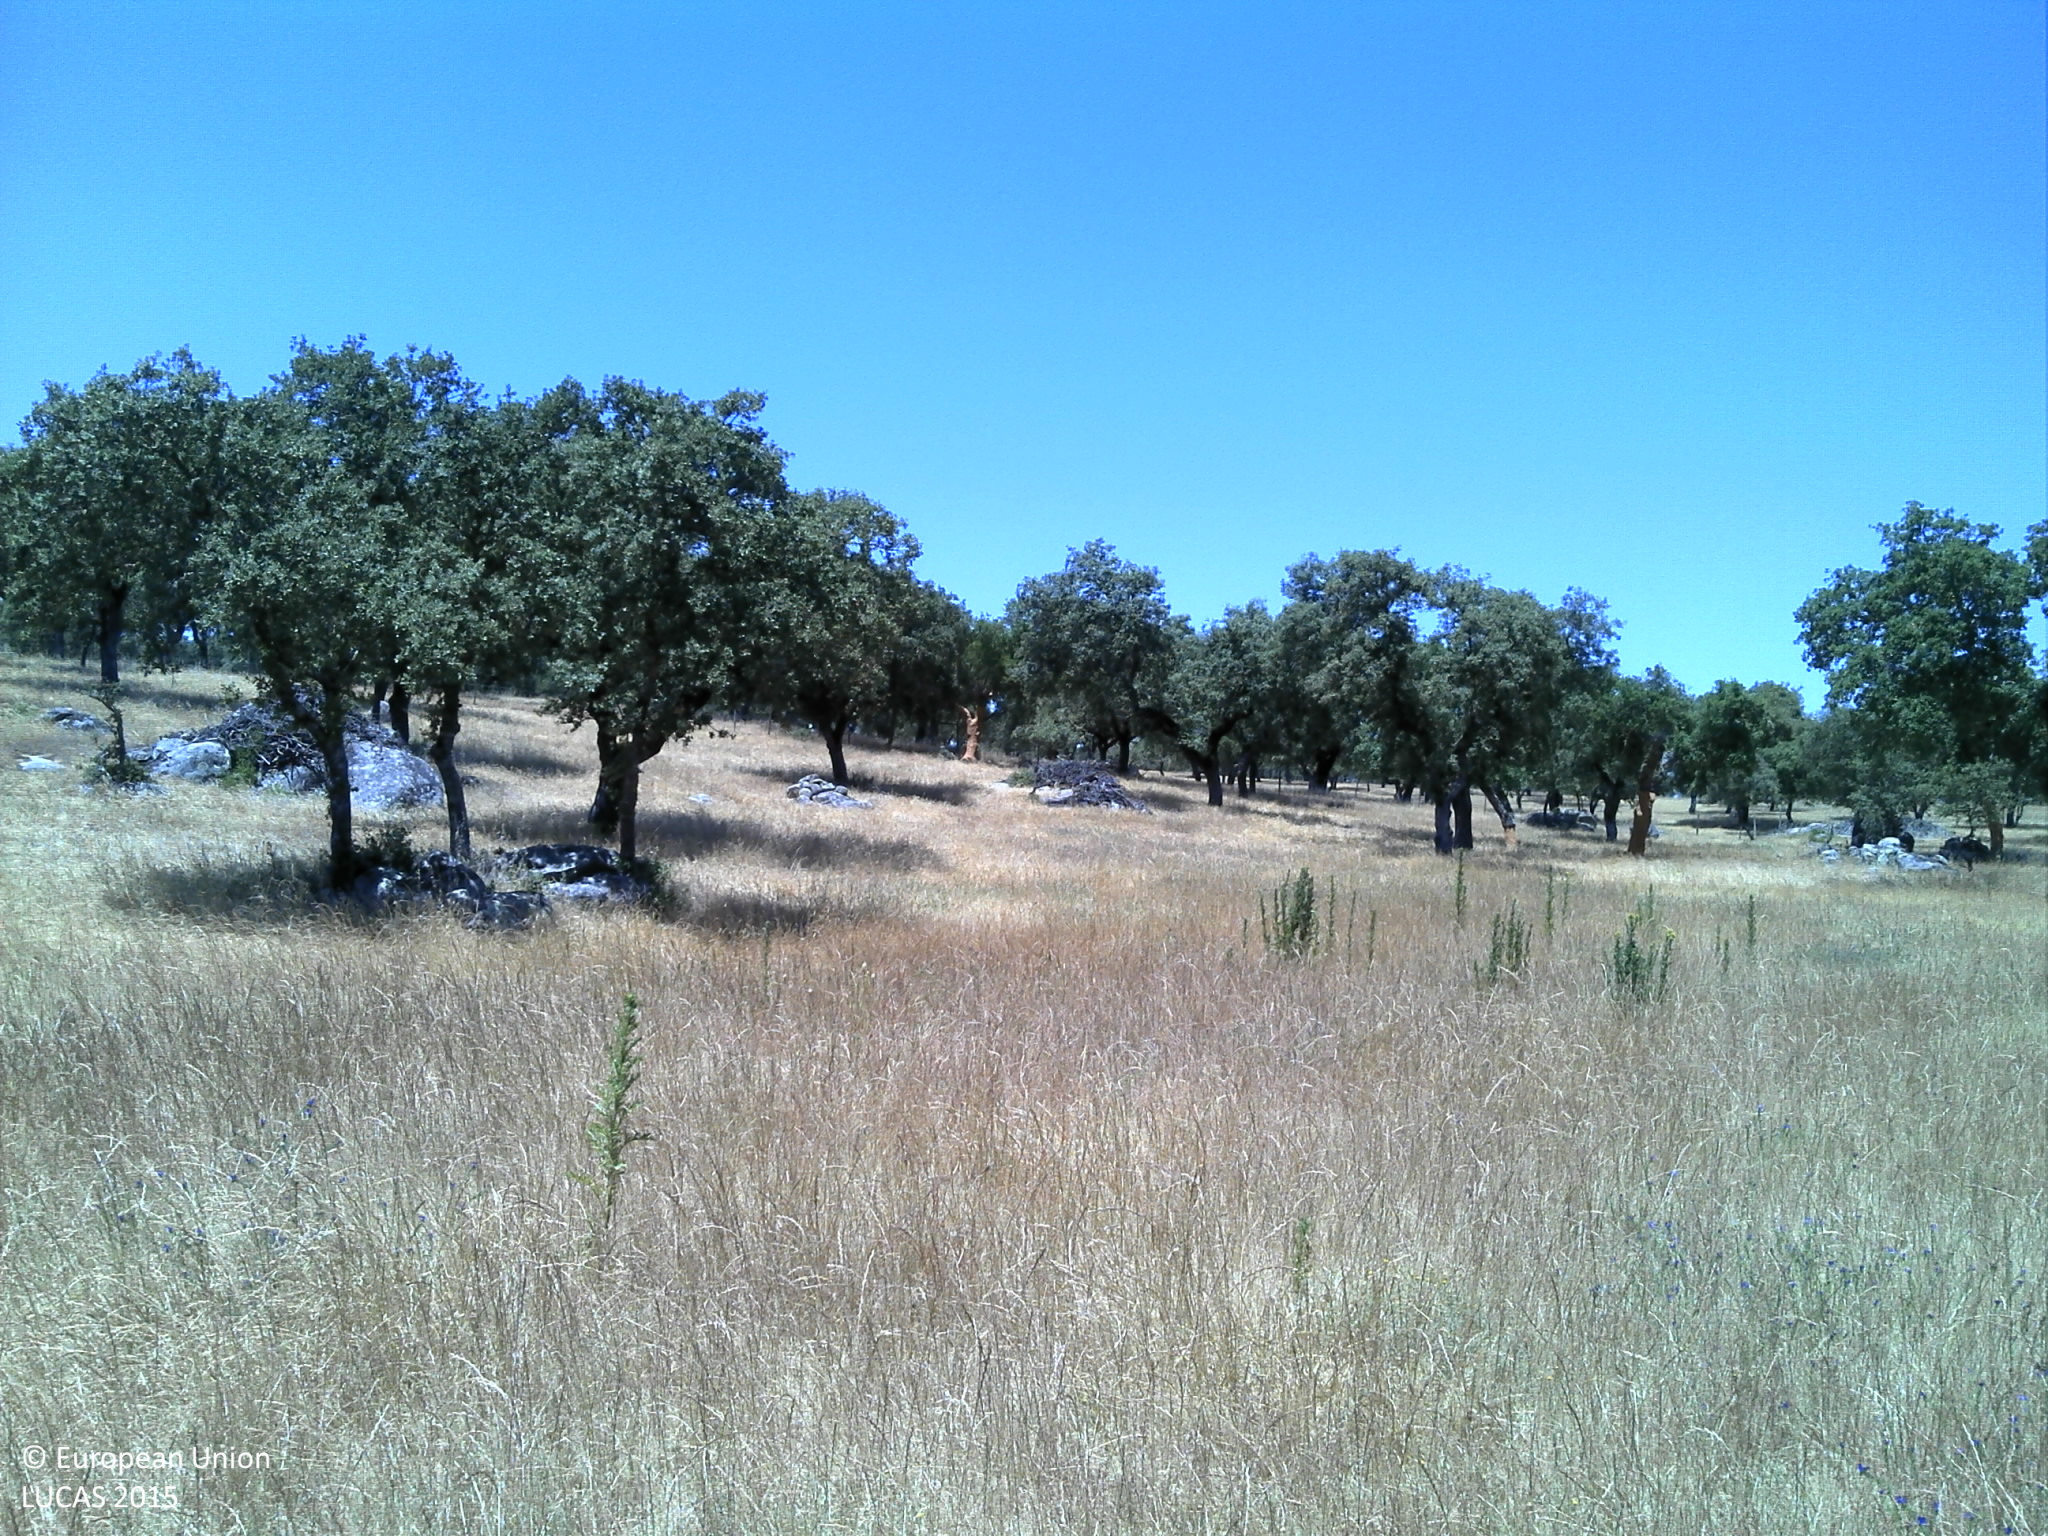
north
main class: Grassland
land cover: Grassland without tree/shrub cover
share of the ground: > 75 %
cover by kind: herbaceous plants 90 %, unconsolidated bare surface 10 %
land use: Agriculture (excluding fallow land and kitchen gardens)
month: May
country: PT
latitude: 38.8094
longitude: -8.0940
